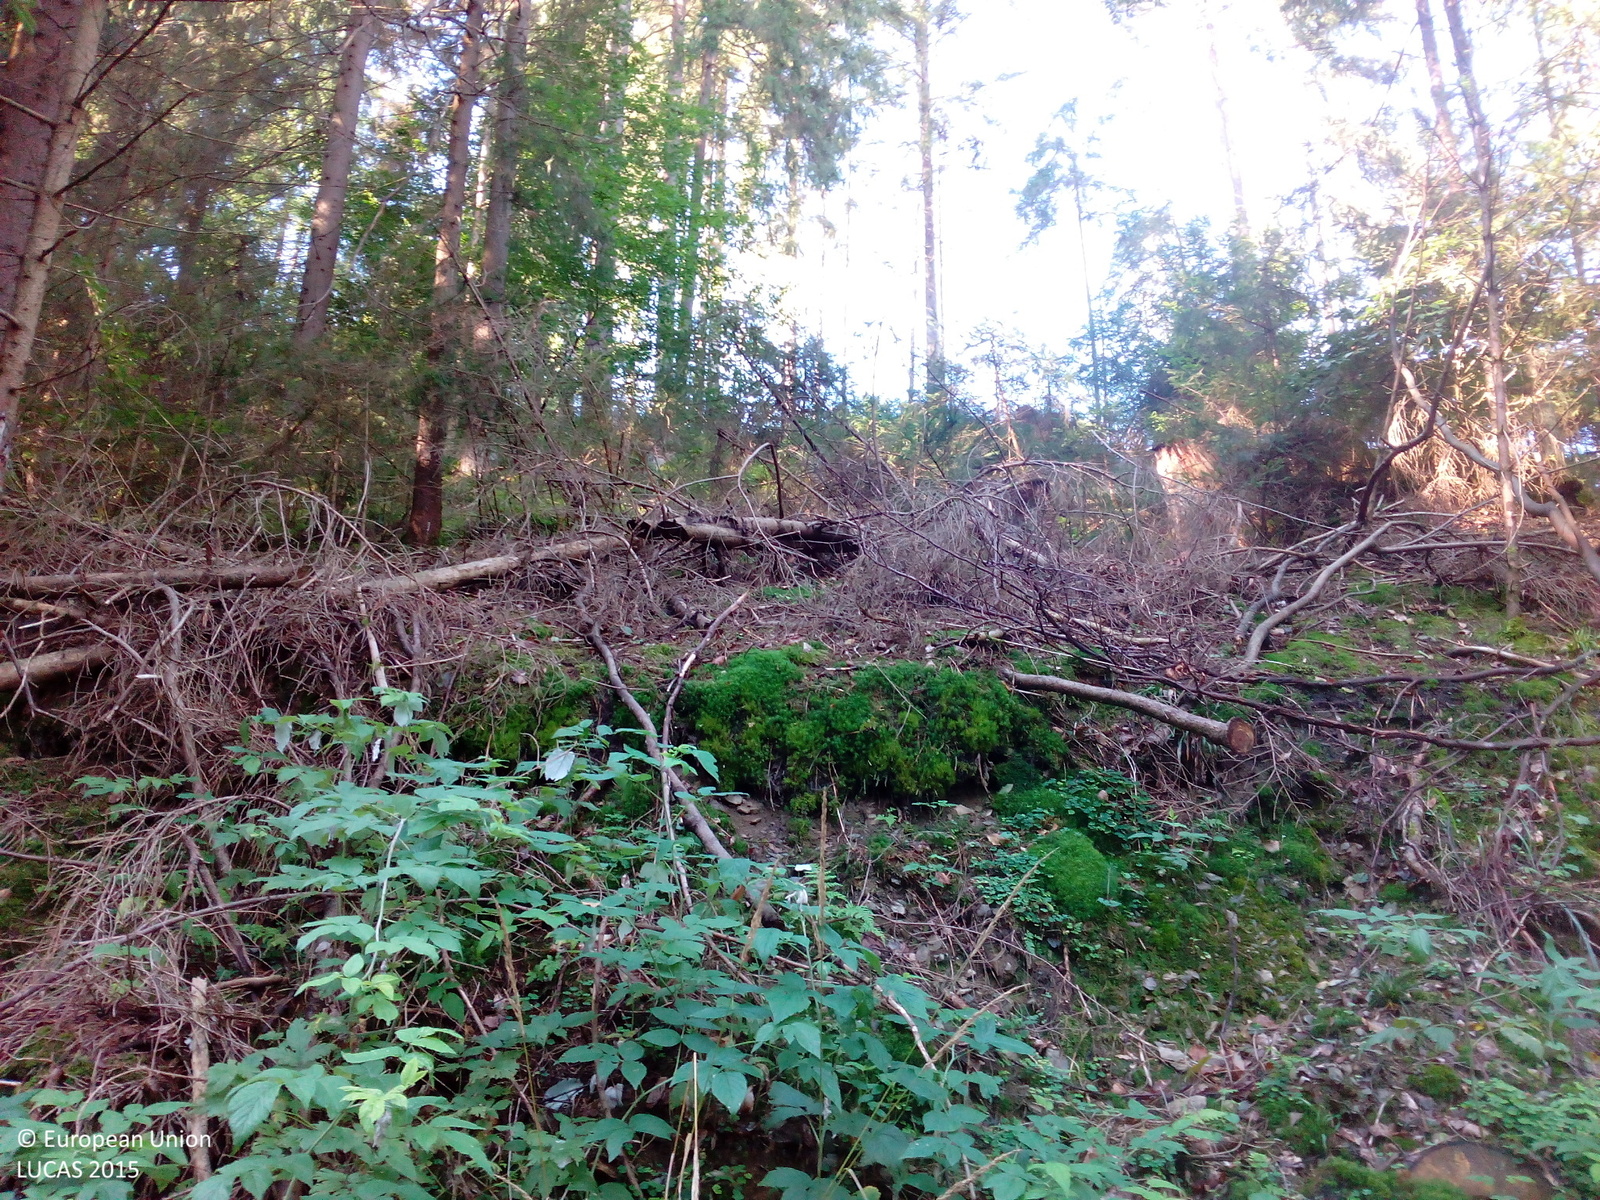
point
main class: Woodland
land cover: Spruce dominated coniferous woodland
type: hemiboreal forest and nemoral coniferous forest and mixed broadleaved-coniferous forest
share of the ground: > 75 %
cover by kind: coniferous forest trees 80 %, broadleaved forest trees 10 %
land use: Forestry
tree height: > 5 m
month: August
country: DE
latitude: 50.3178
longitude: 11.5304
